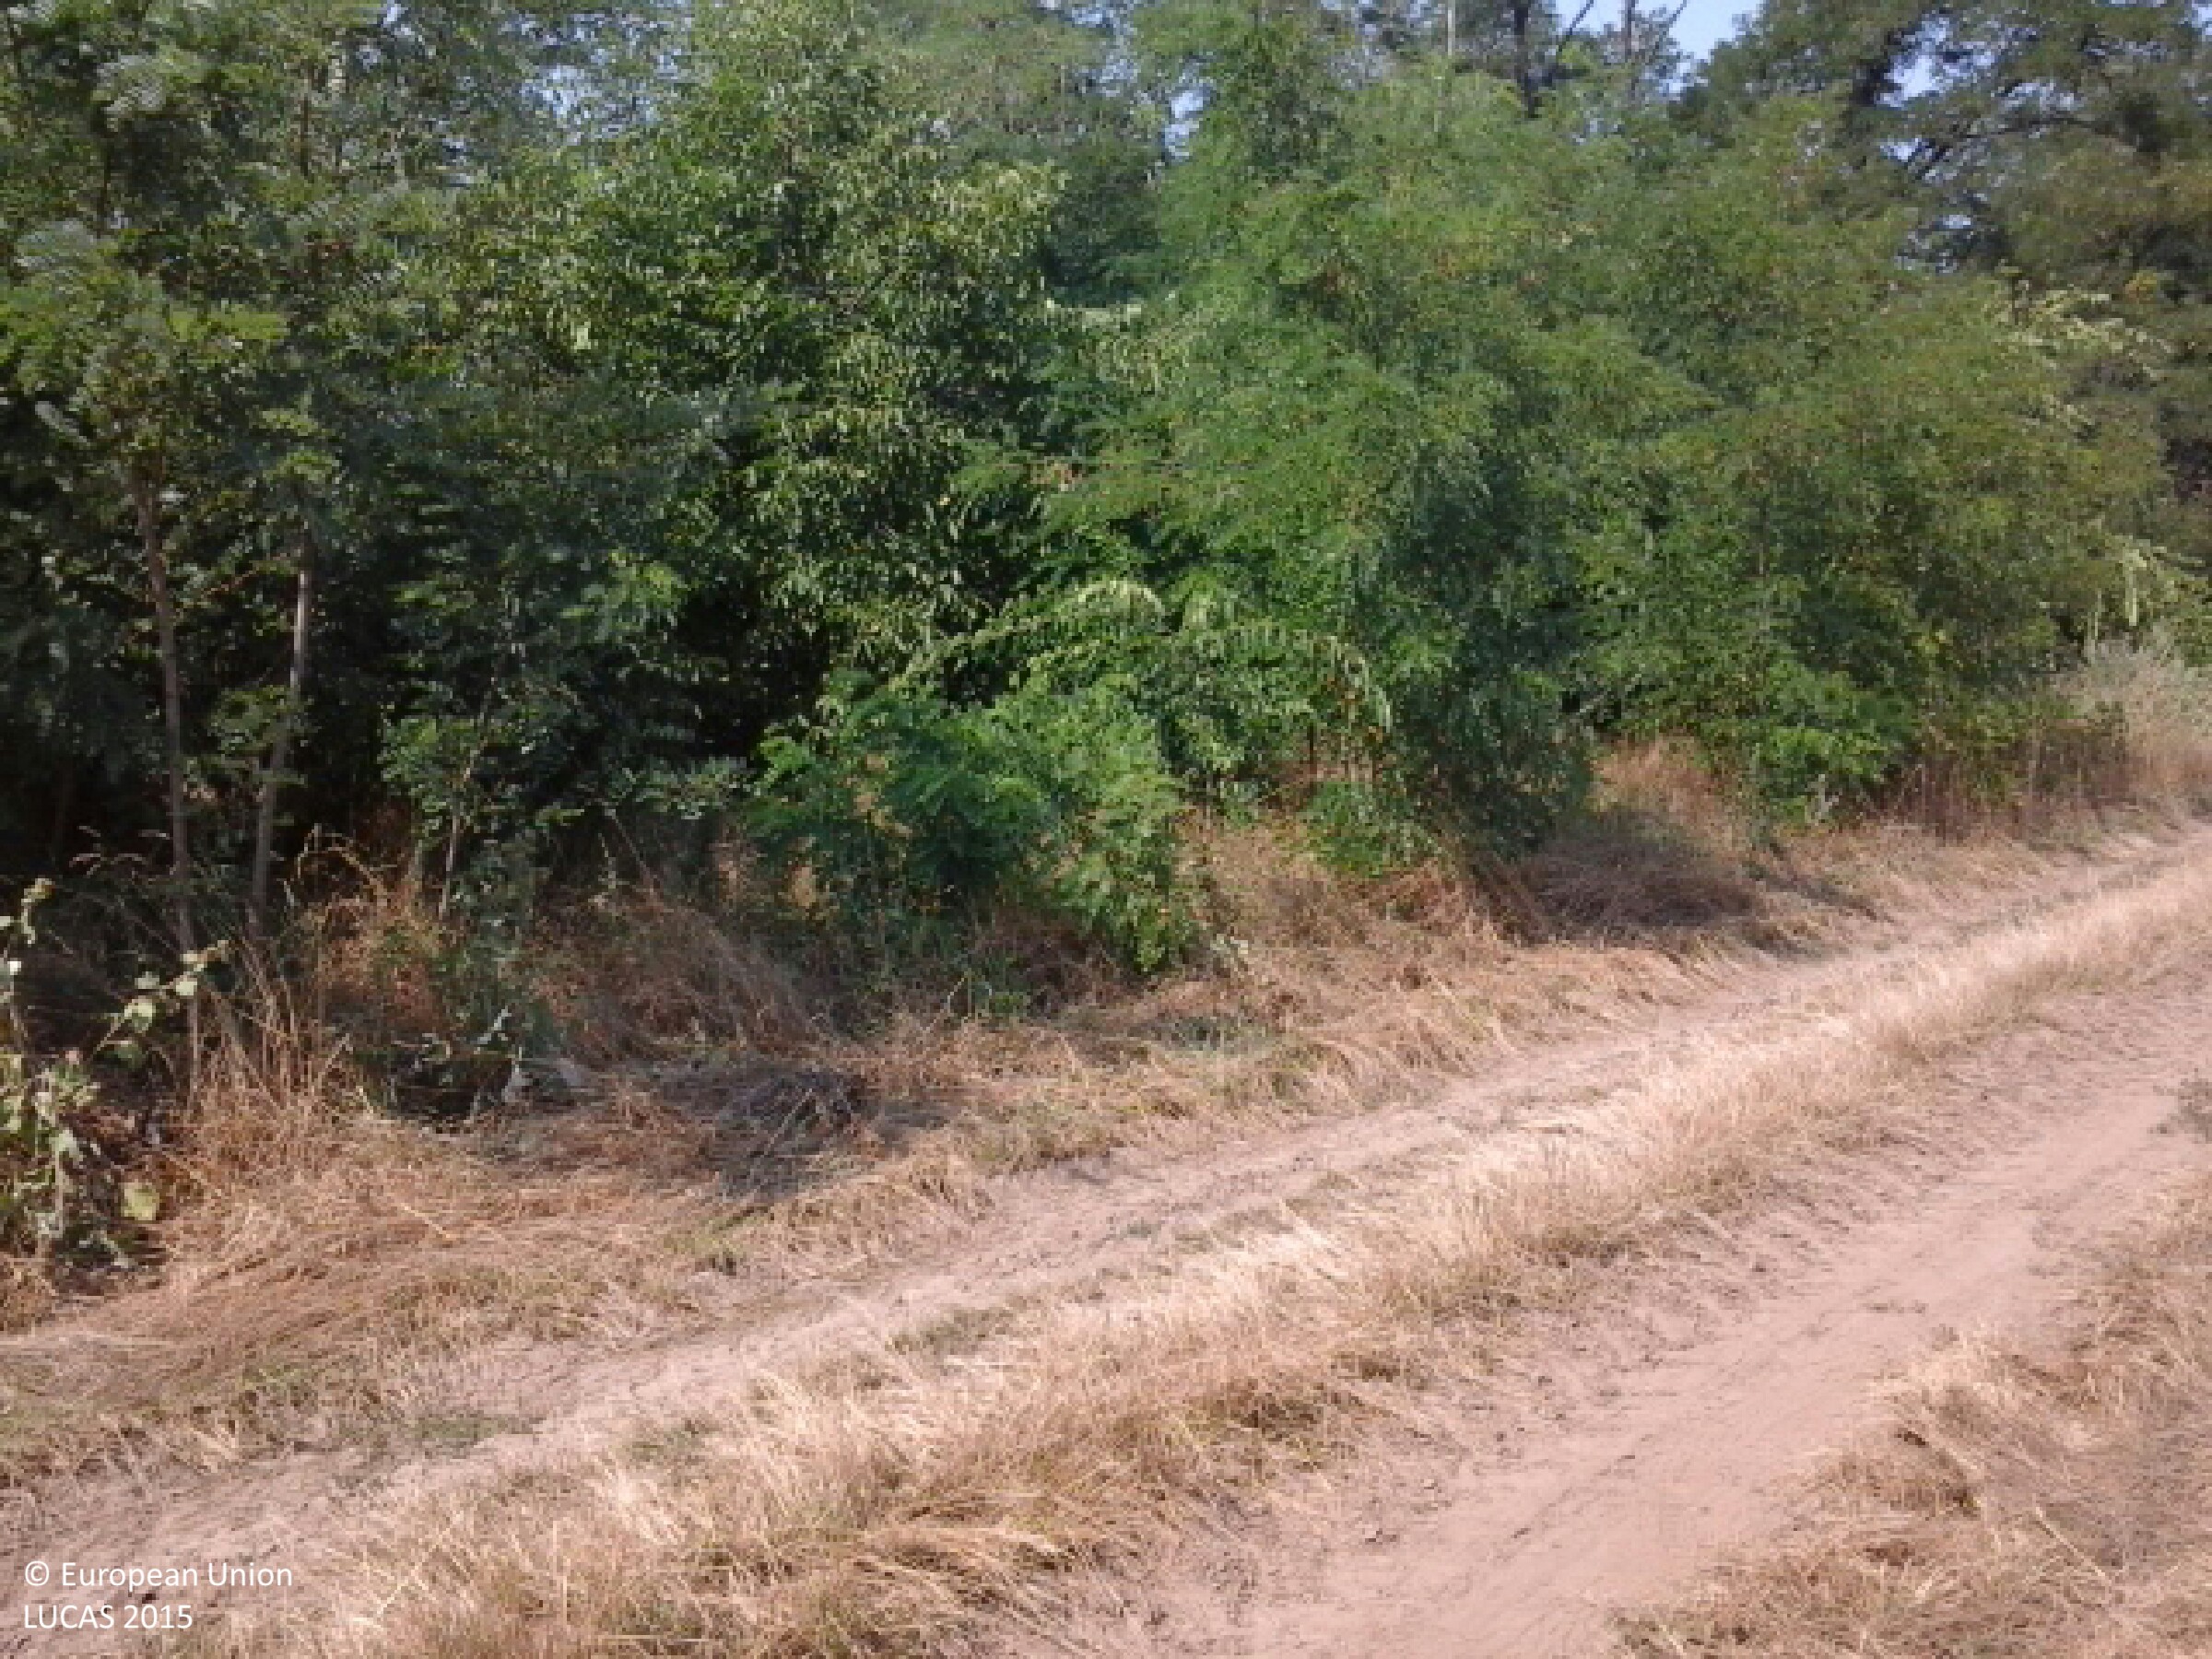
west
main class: Cropland
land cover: Common wheat
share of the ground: < 10 %
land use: Agriculture (excluding fallow land and kitchen gardens)
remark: Harvested field
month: August
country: HU
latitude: 47.6186
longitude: 18.0878
